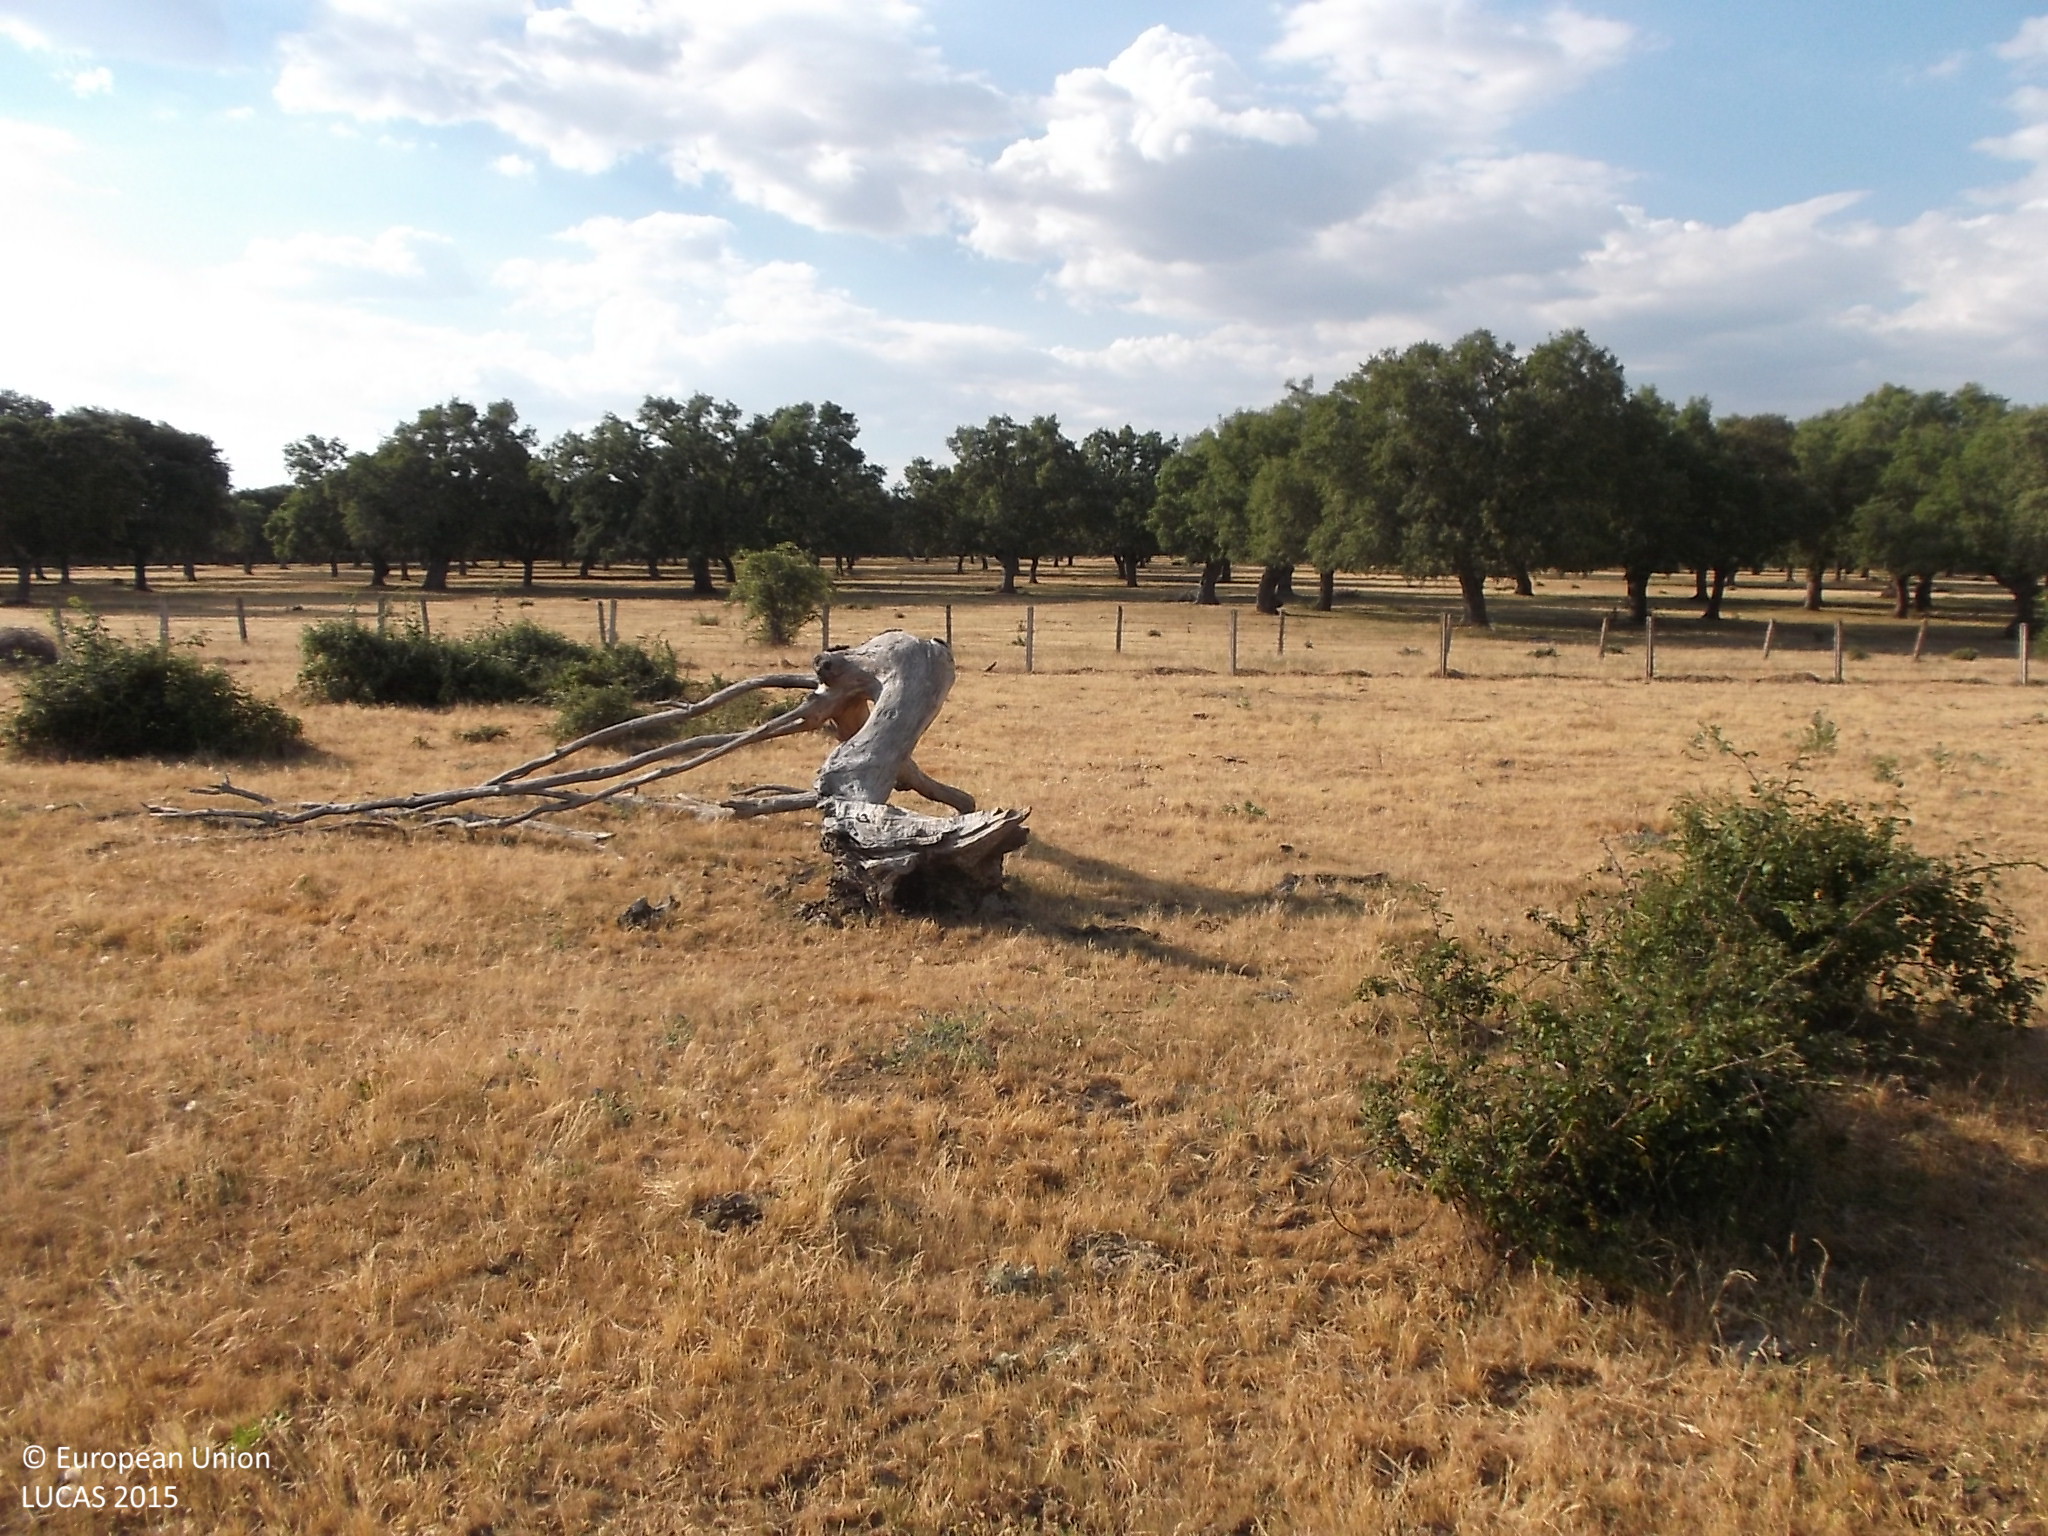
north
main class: Grassland
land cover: Grassland with sparse tree/shrub cover
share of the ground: > 75 %
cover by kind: herbaceous plants 90 %, broadleaved forest trees 5 %, shrubs 5 %
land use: Agriculture (excluding fallow land and kitchen gardens)
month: June
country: ES
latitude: 40.8682
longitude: -6.3811
